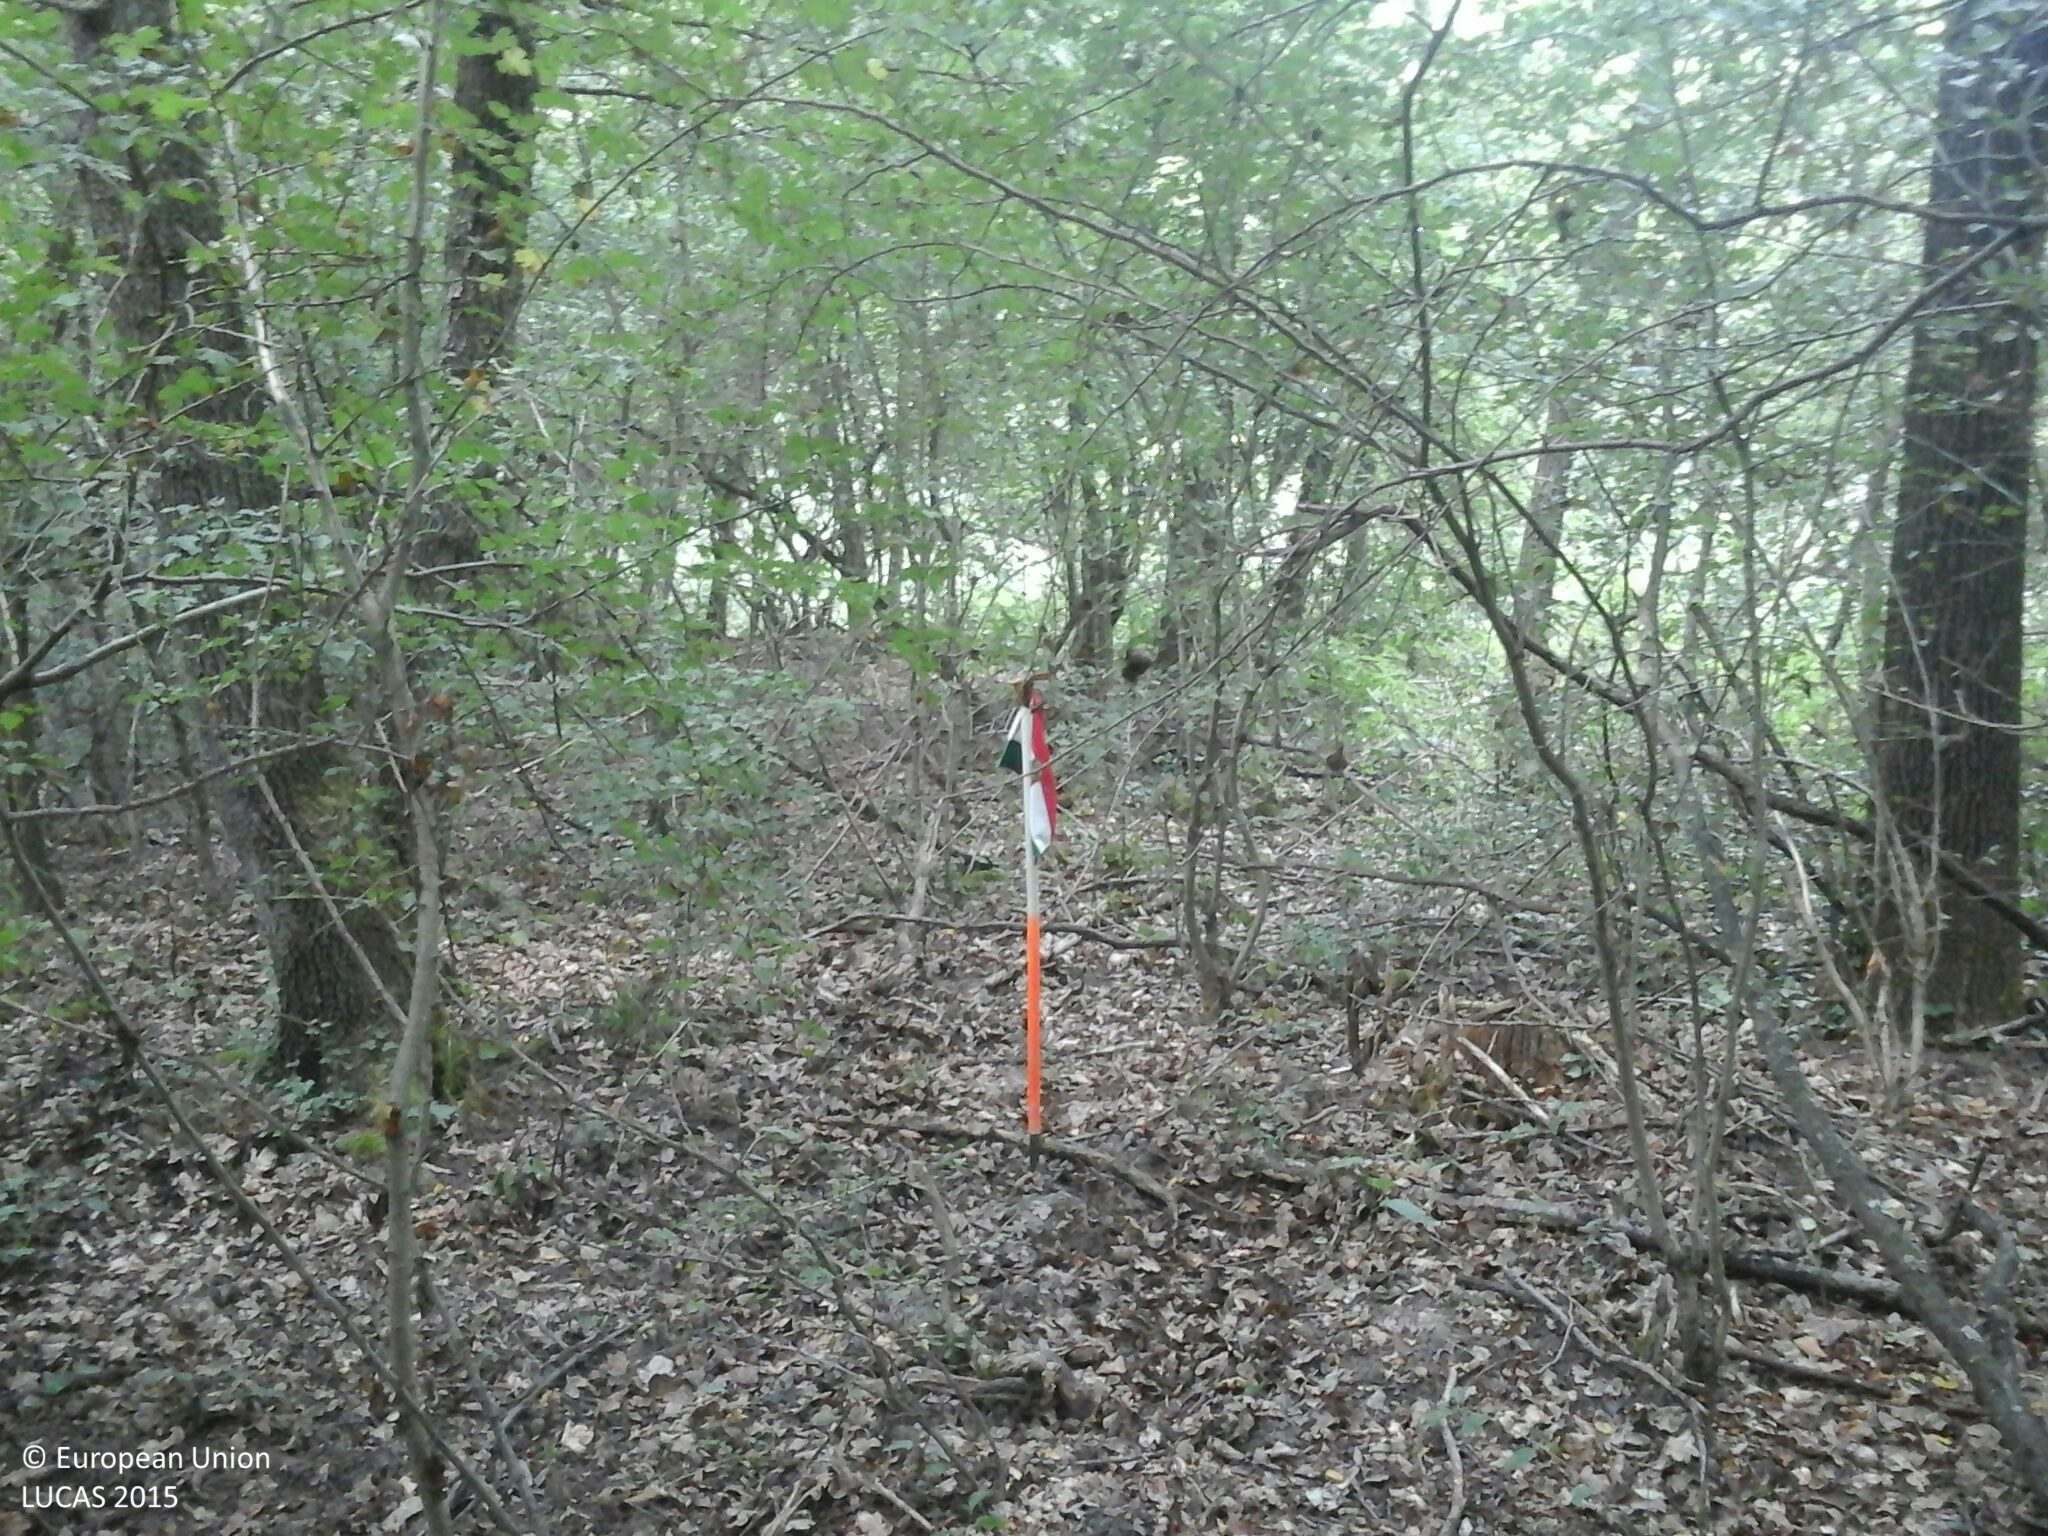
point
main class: Woodland
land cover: Broadleaved woodland
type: thermophilous deciduous forest
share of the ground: > 75 %
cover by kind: broadleaved forest trees 100 %
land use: Forestry
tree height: > 5 m
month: August
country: HU
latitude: 45.8323
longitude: 18.2584
